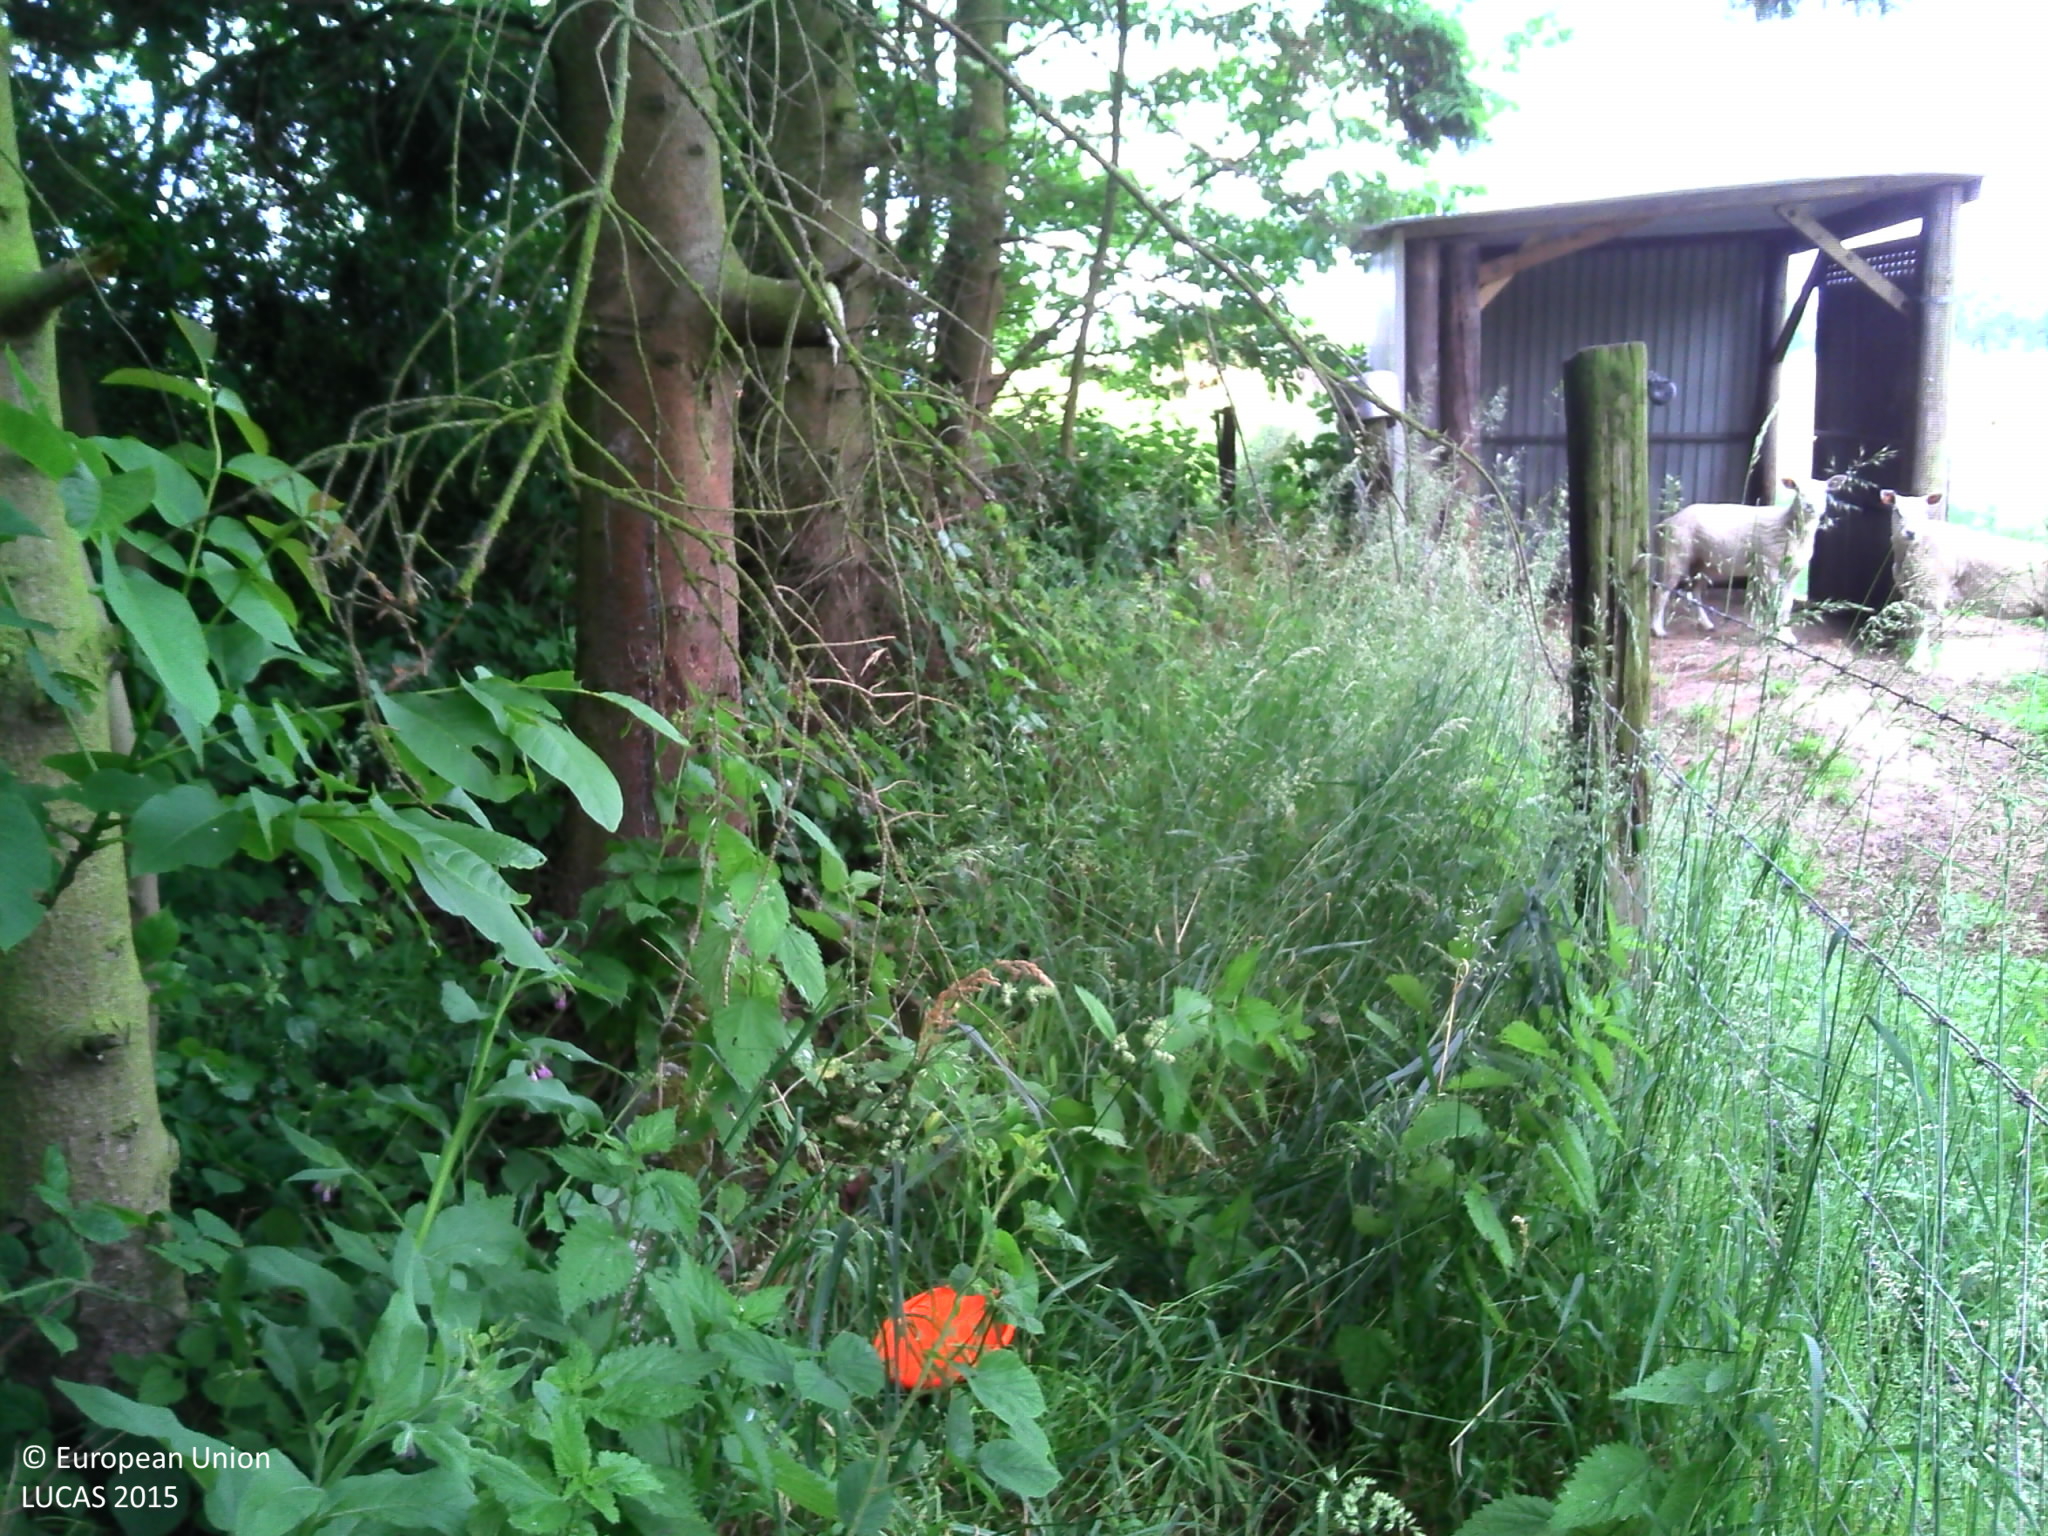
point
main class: Woodland
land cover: Spruce dominated mixed woodland
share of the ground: > 75 %
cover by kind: coniferous forest trees 40 %, broadleaved forest trees 35 %, herbaceous plants 25 %
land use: Forestry
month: June
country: BE
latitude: 50.9338
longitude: 4.1178
